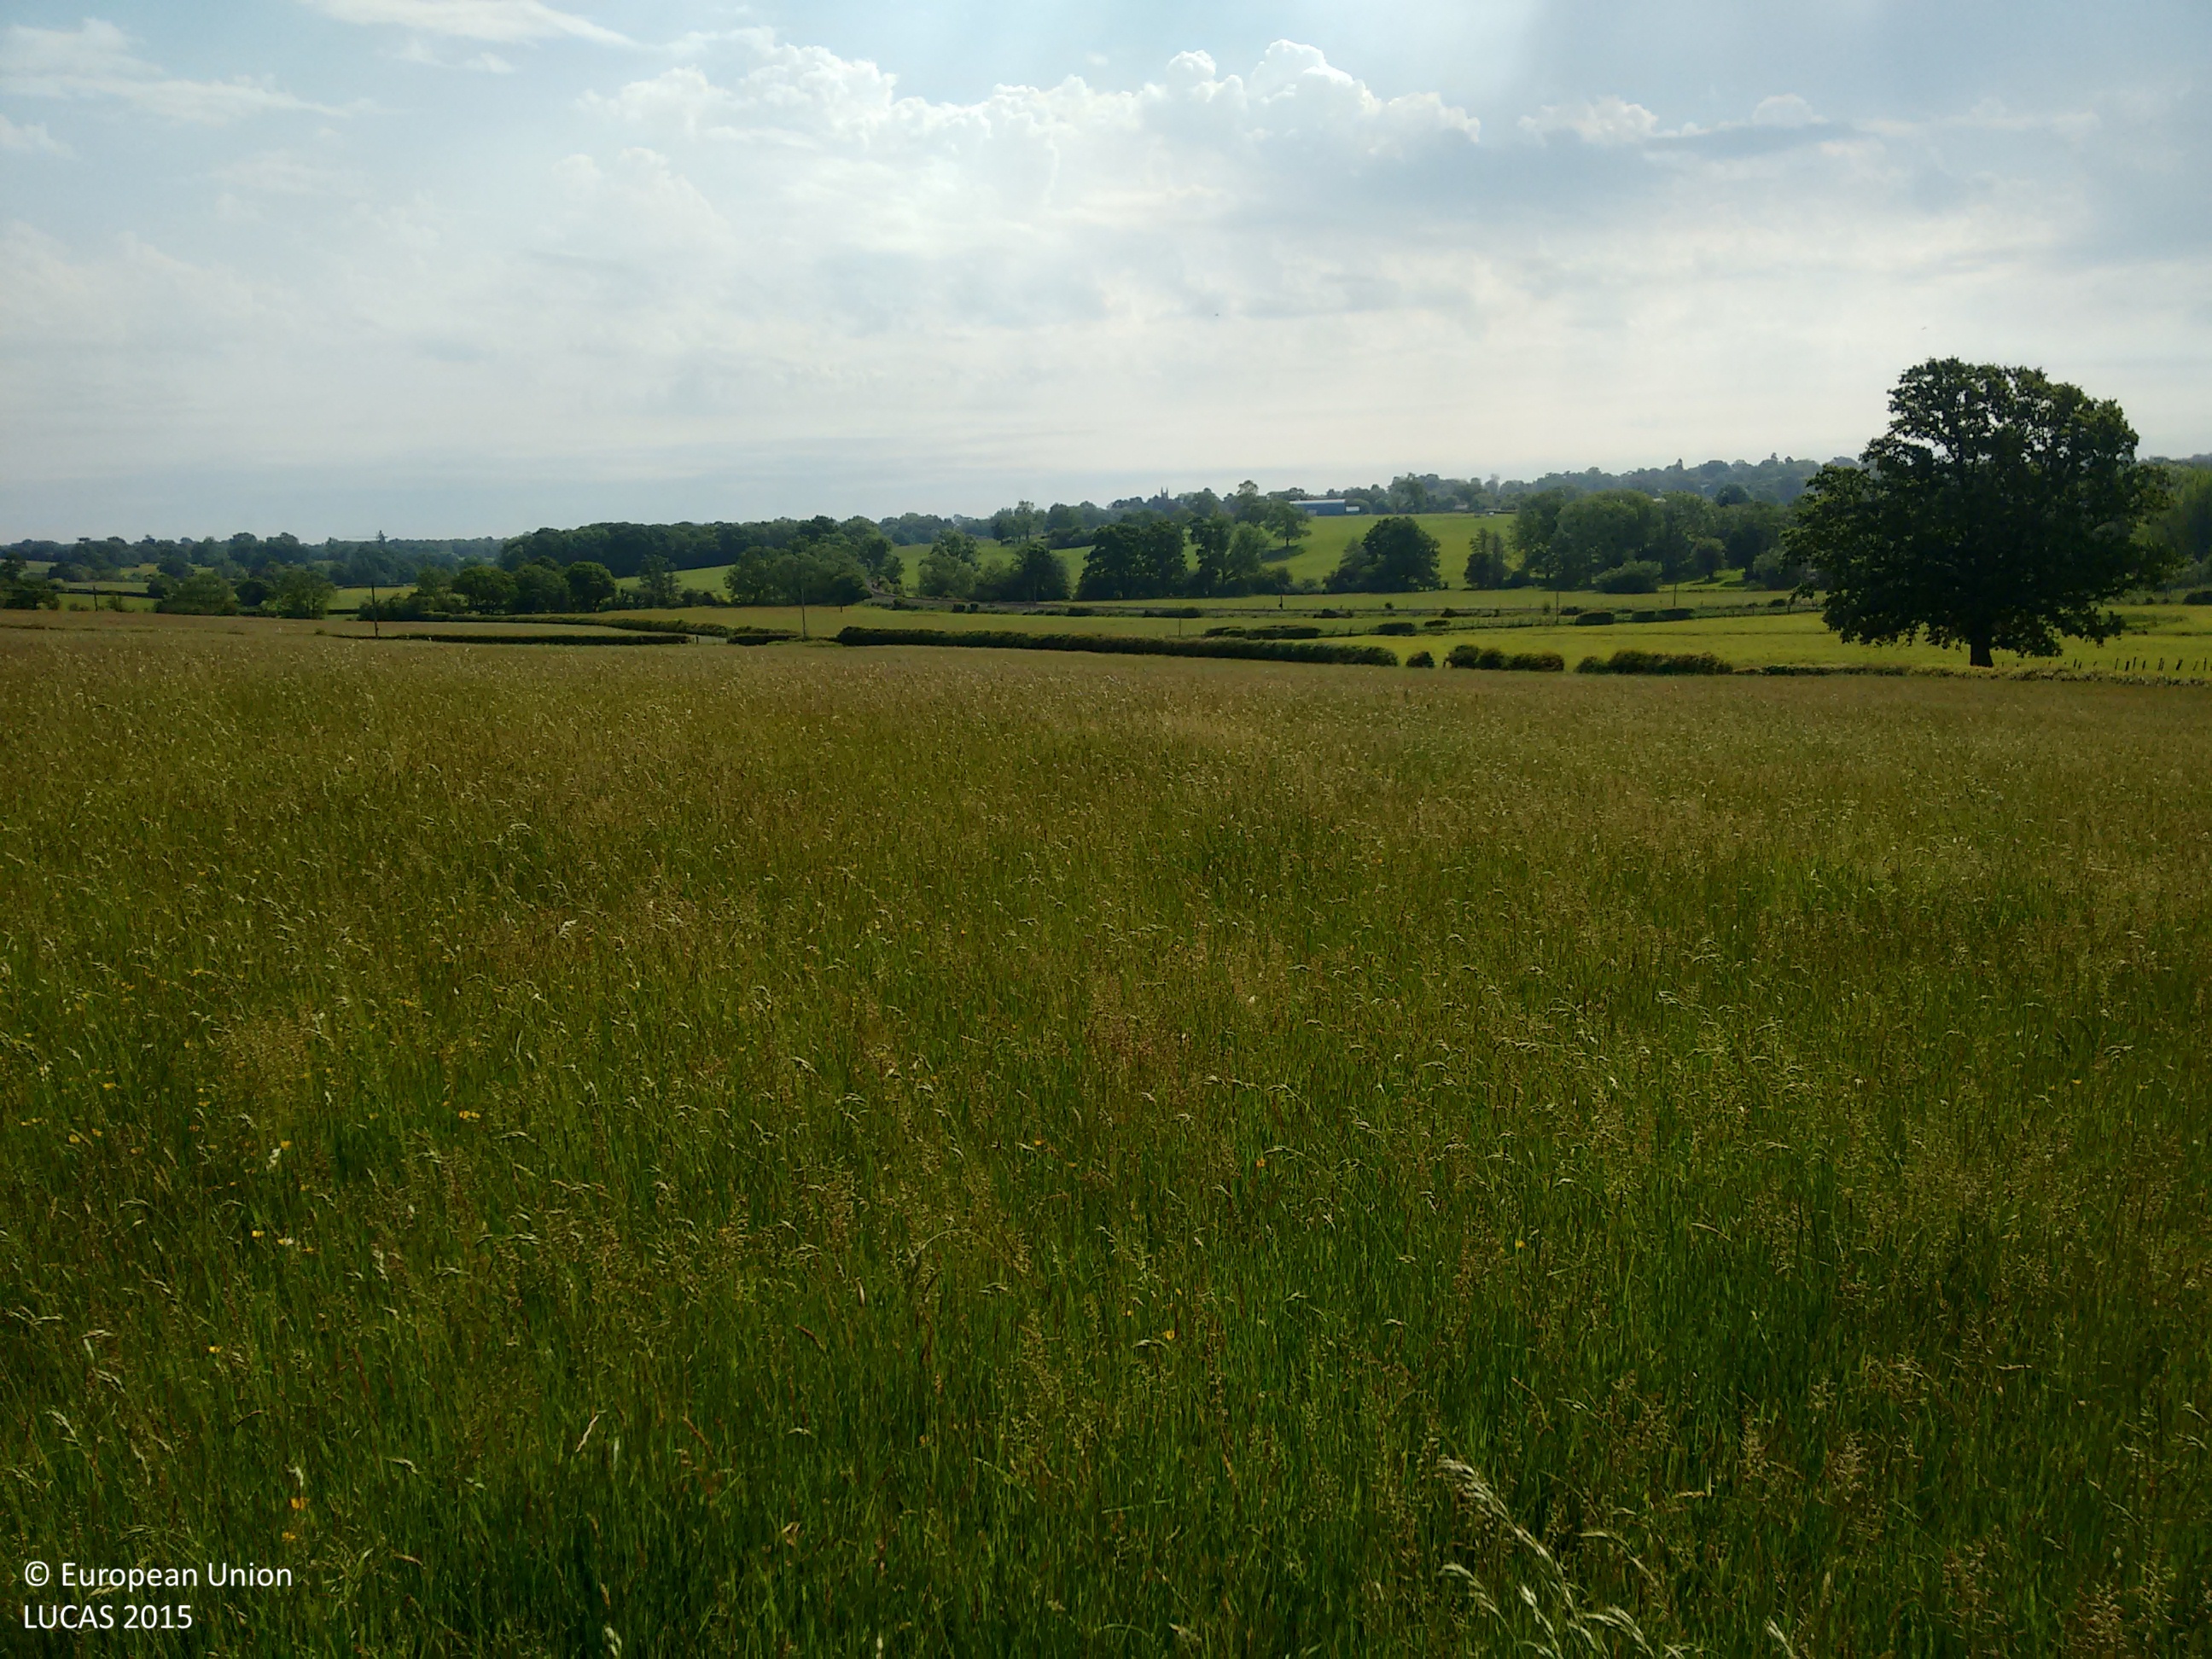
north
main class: Grassland
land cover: Grassland without tree/shrub cover
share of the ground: > 75 %
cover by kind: herbaceous plants 100 %
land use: Agriculture (excluding fallow land and kitchen gardens)
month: June
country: GB
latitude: 51.0669
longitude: 0.6551
